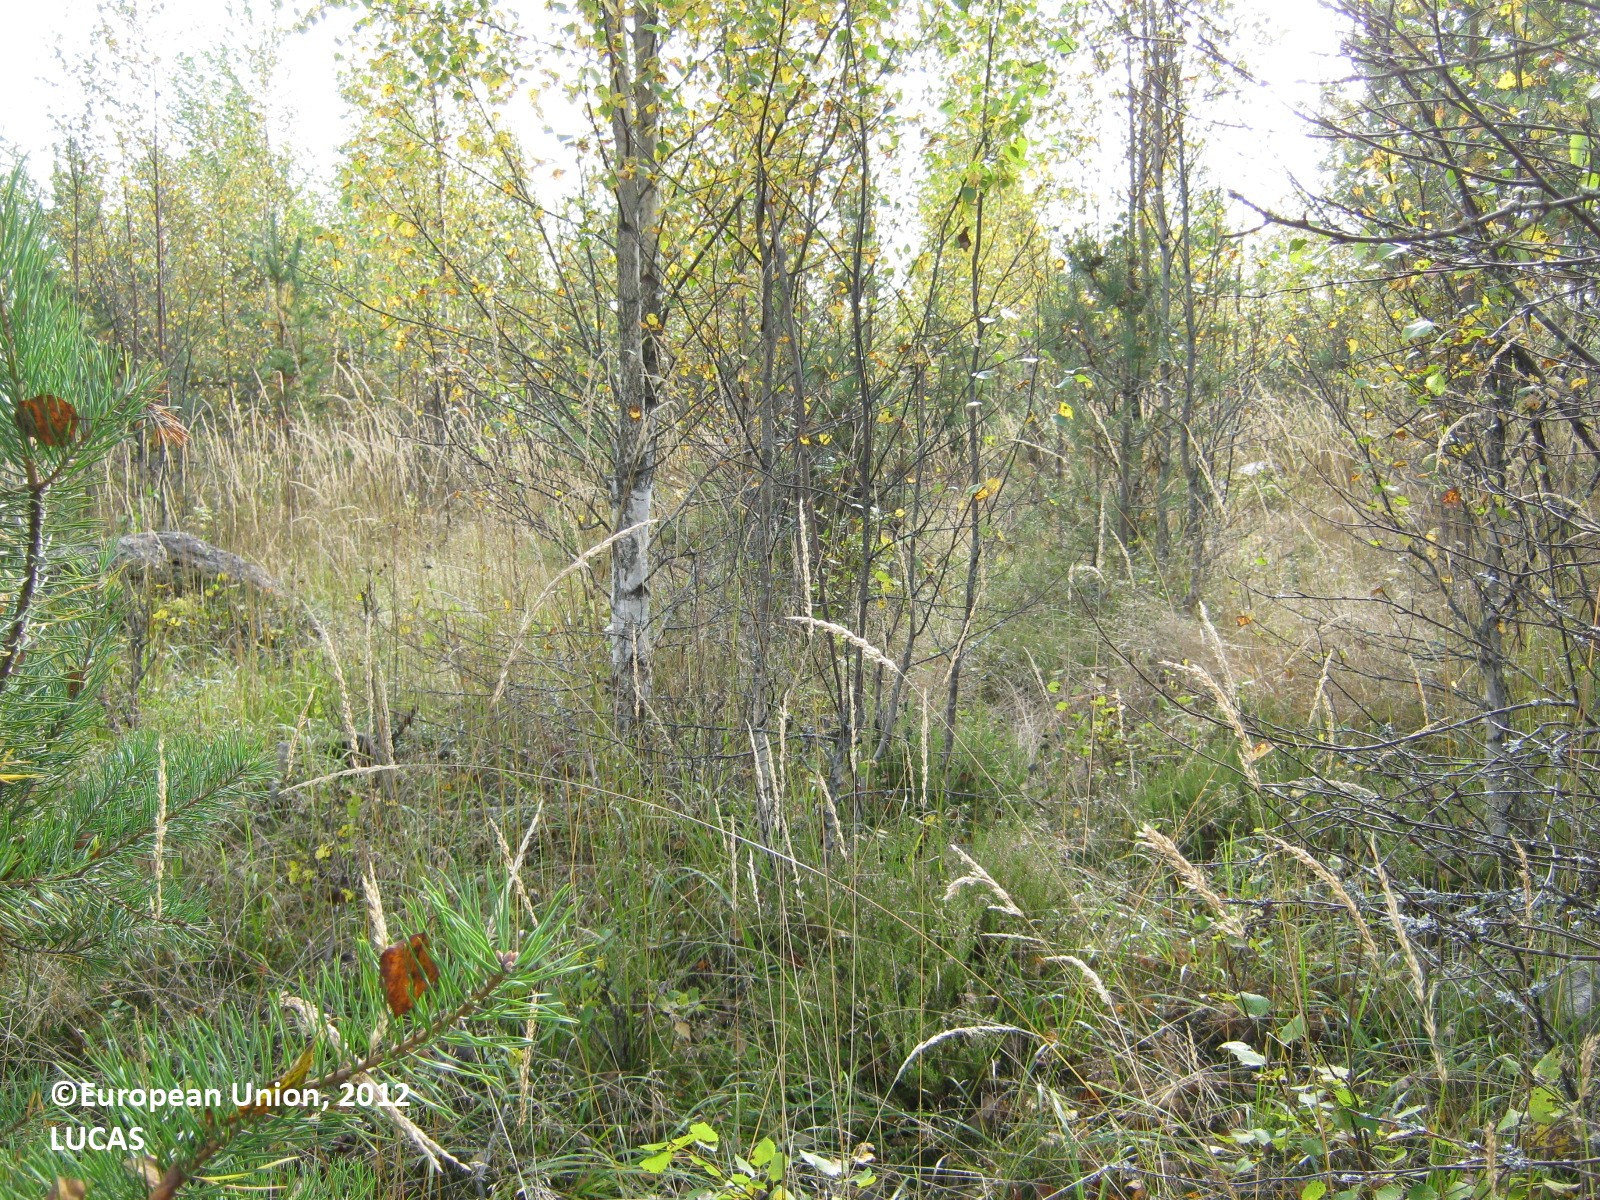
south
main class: Woodland
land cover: Other mixed woodland
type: boreal forest
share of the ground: 50 - 75 %
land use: Forestry
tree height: > 5 m
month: September
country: FI
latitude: 60.9564
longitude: 28.1341
